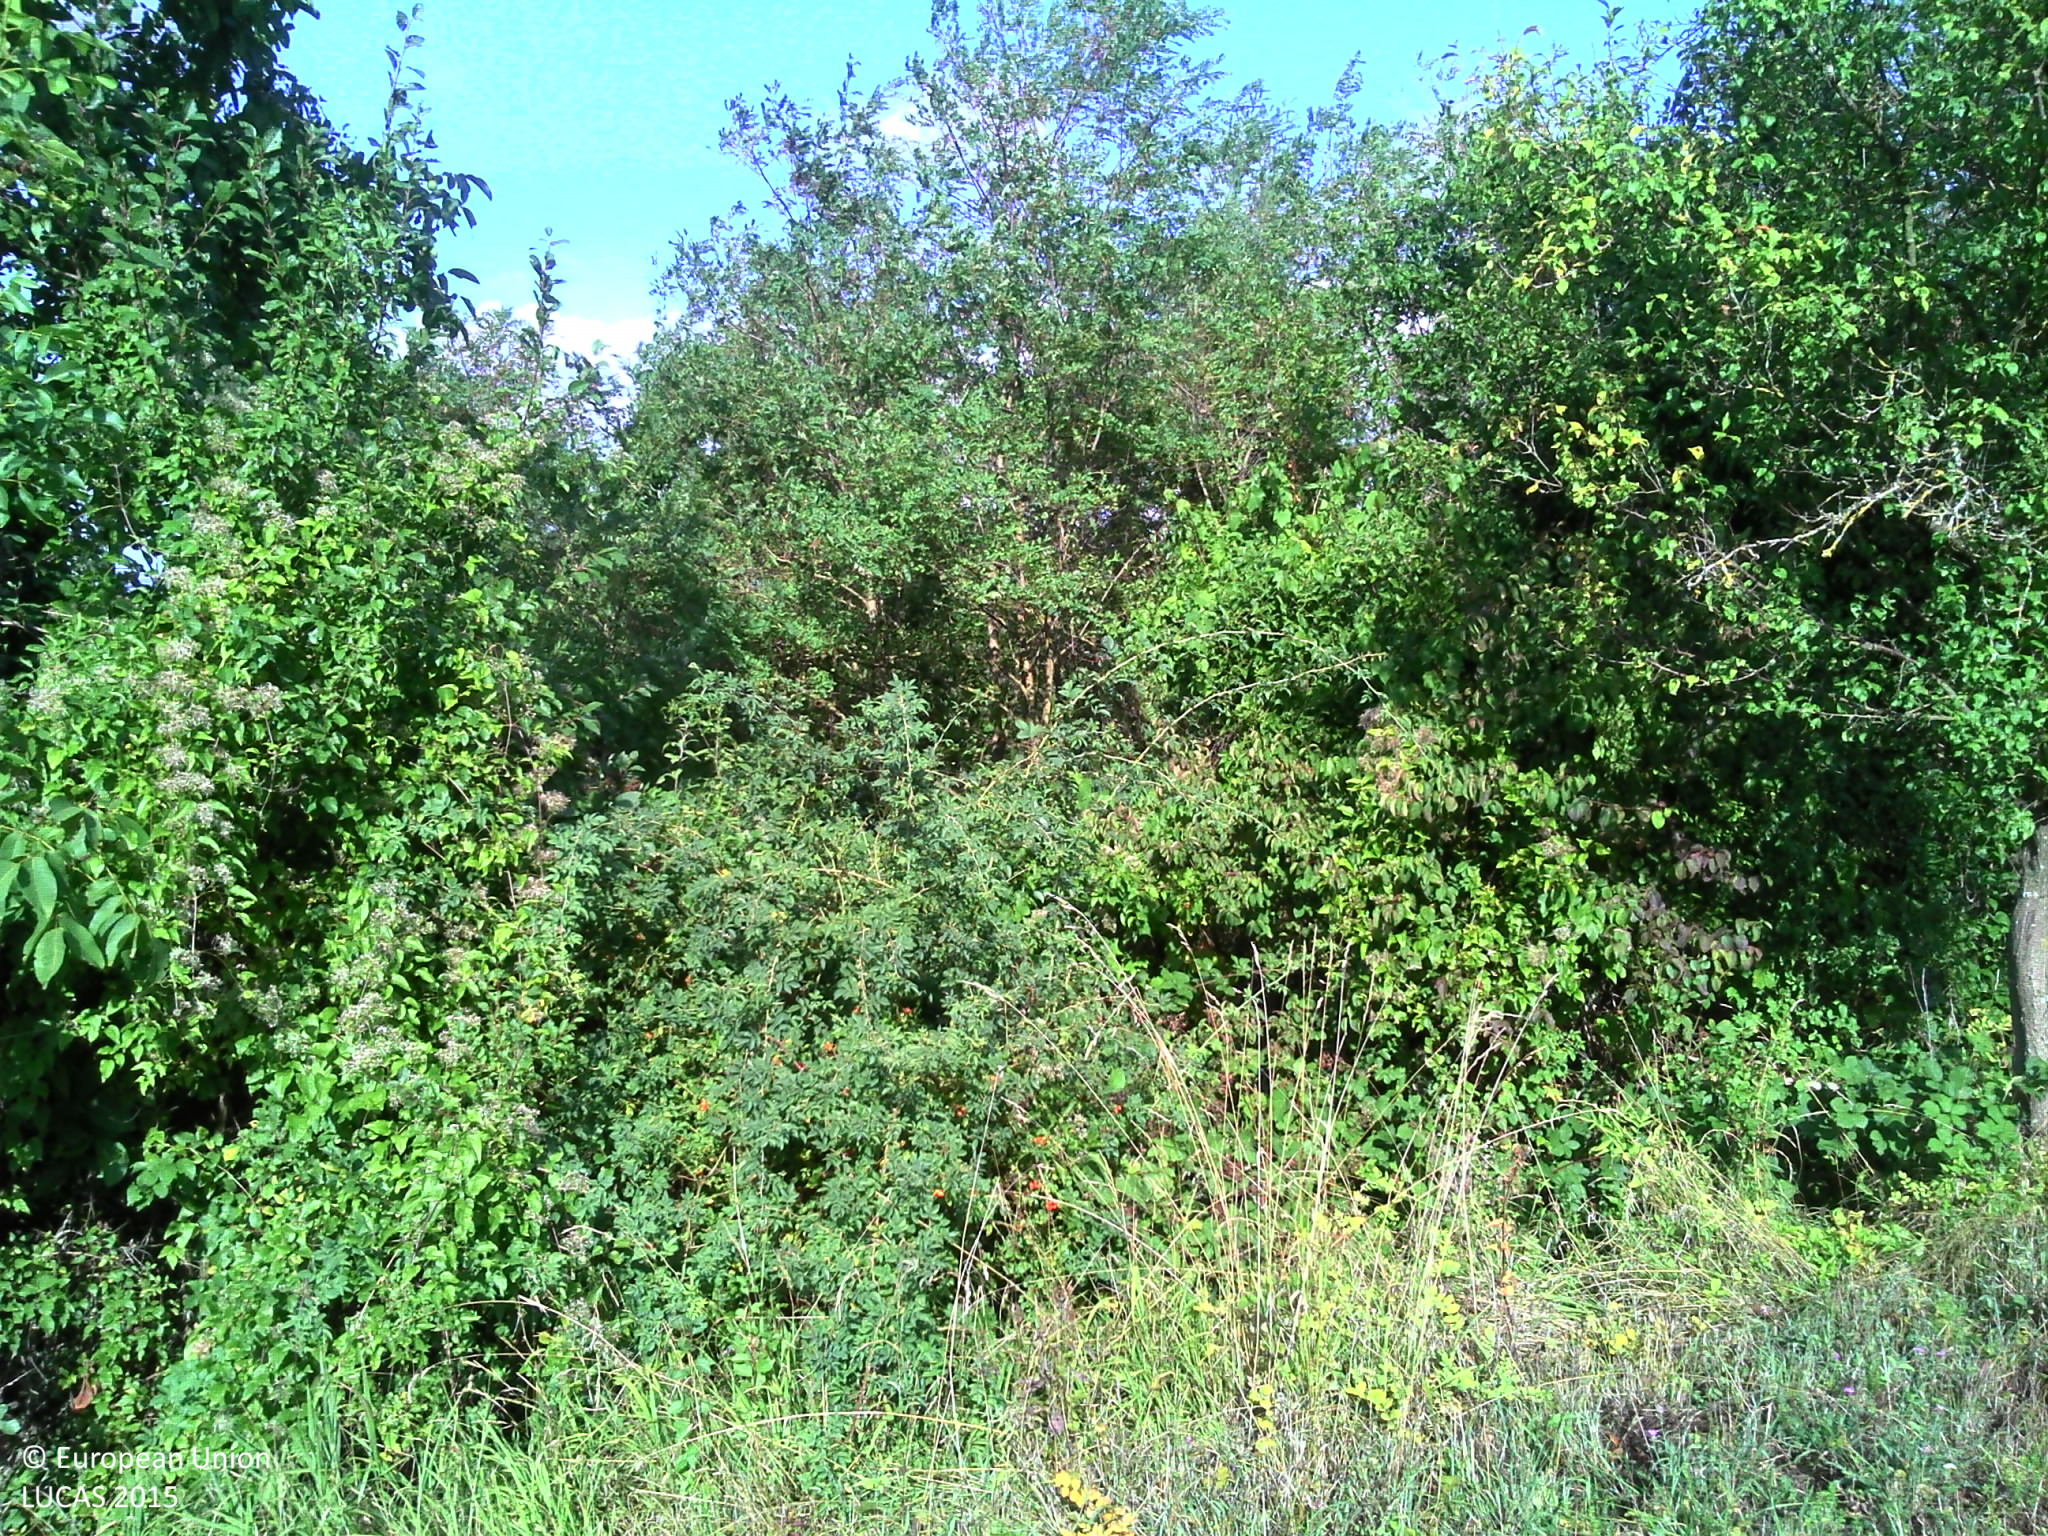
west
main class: Grassland
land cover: Grassland without tree/shrub cover
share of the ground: > 75 %
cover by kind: herbaceous plants 100 %
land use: Agriculture (excluding fallow land and kitchen gardens)
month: August
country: FR
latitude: 48.8092
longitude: 7.5905
